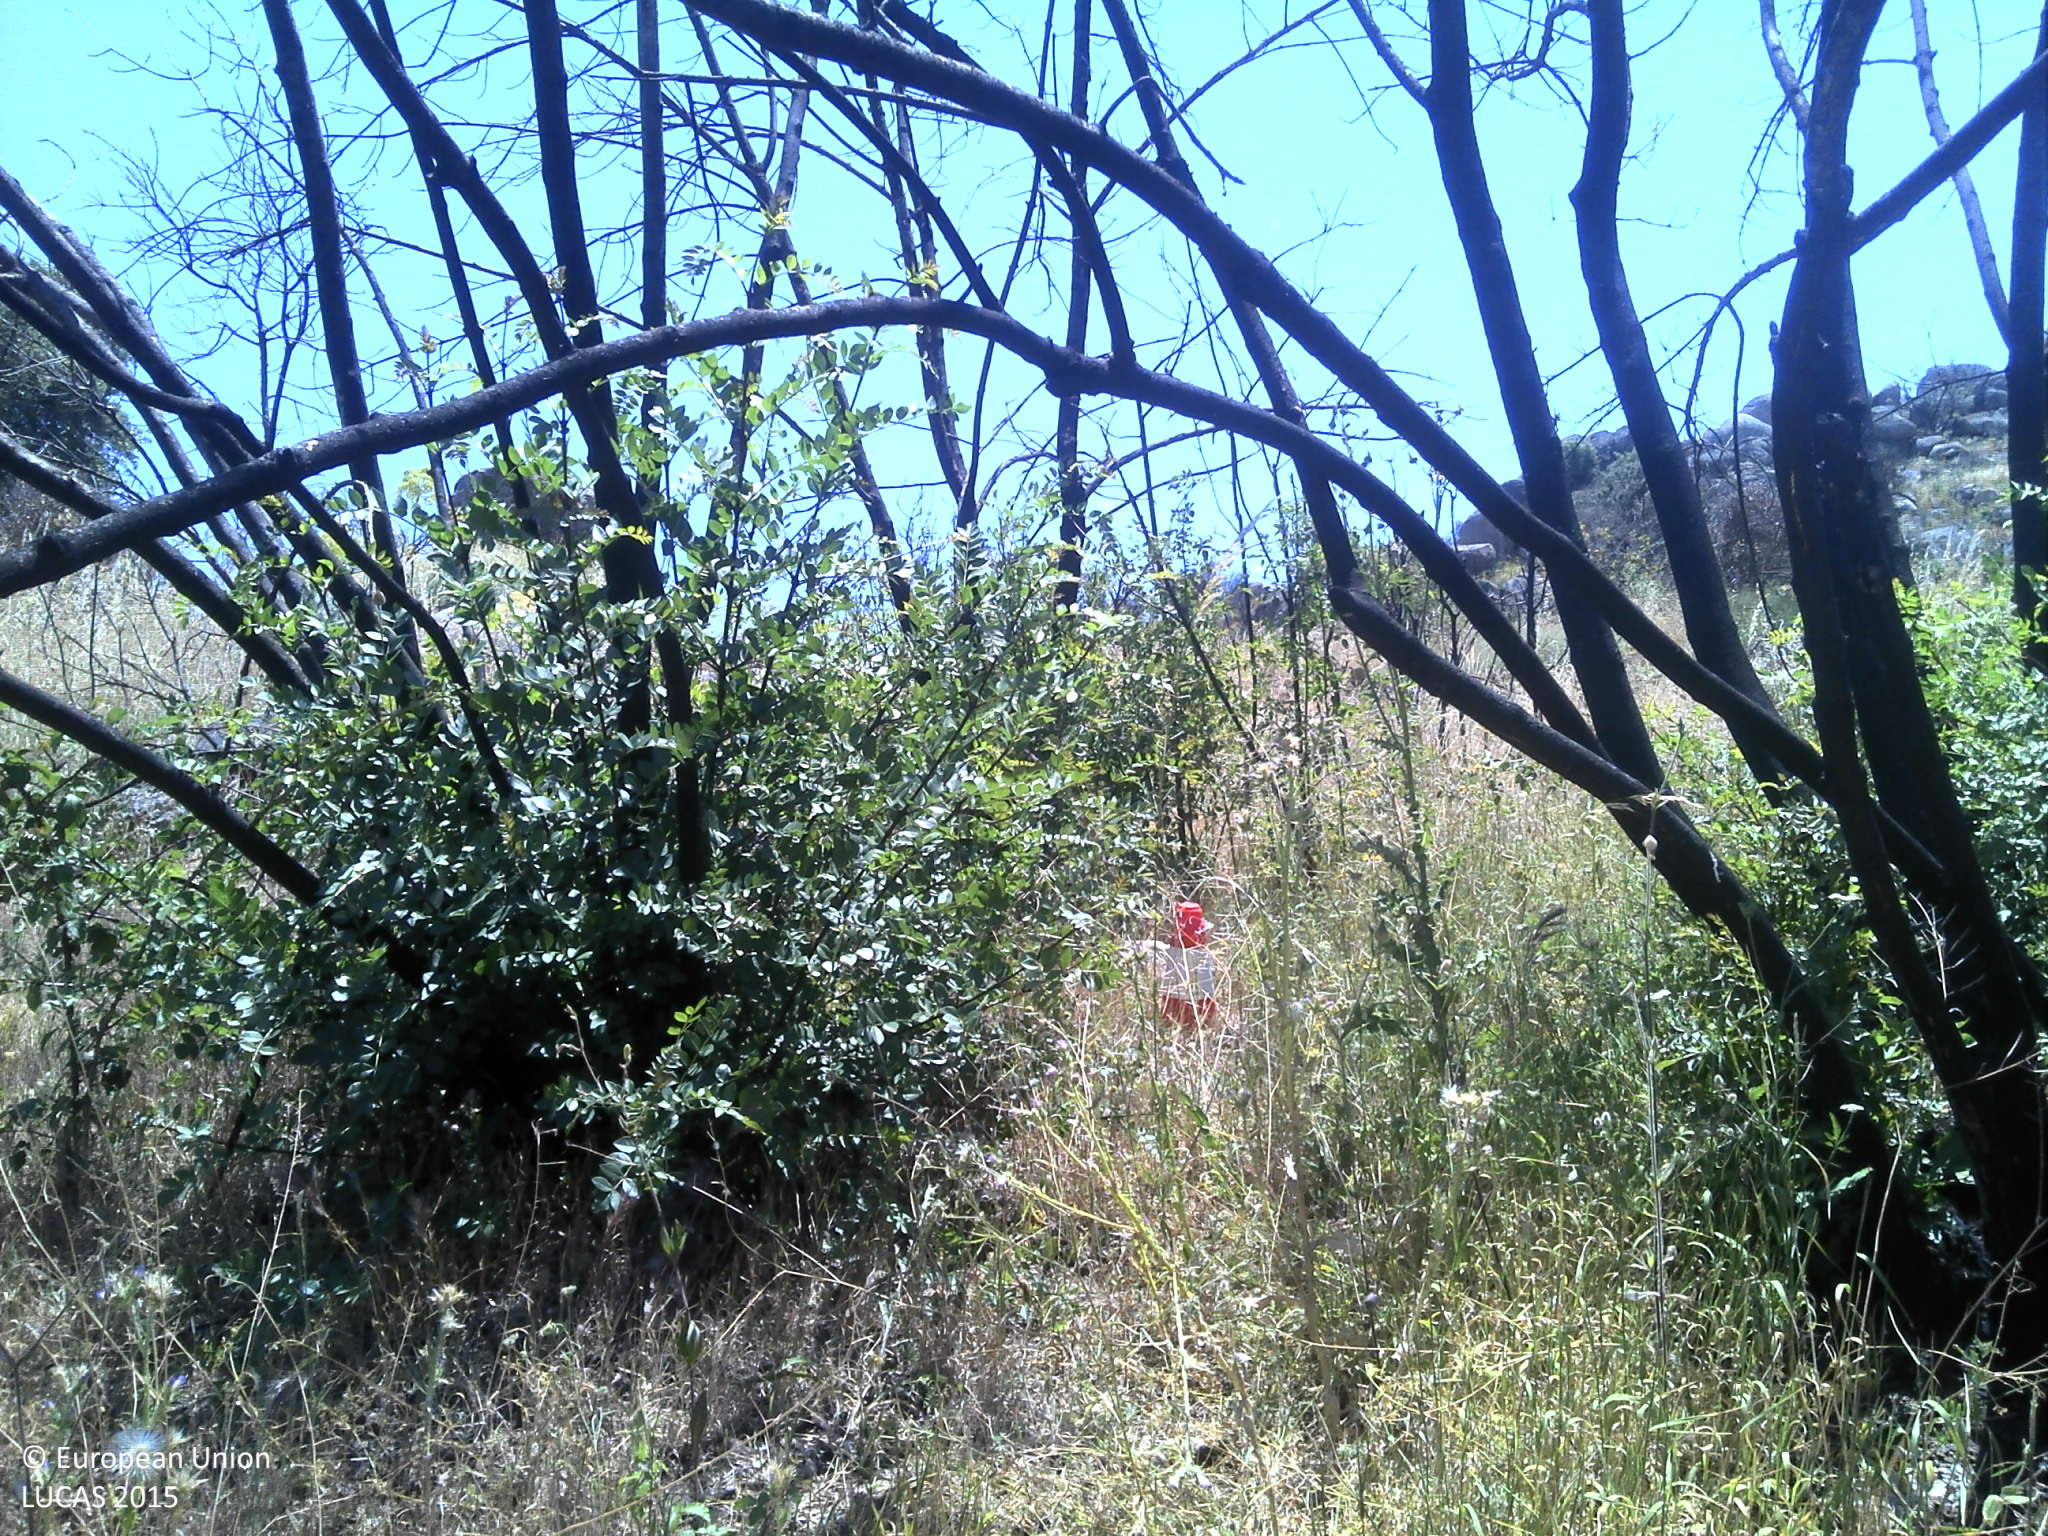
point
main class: Grassland
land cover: Grassland with sparse tree/shrub cover
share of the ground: 50 - 75 %
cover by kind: herbaceous plants 60 %, unconsolidated bare surface 30 %, broadleaved forest trees 5 %, shrubs 5 %
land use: Semi-natural and natural areas not in use
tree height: < 5 m
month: June
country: PT
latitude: 40.6813
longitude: -6.9368
